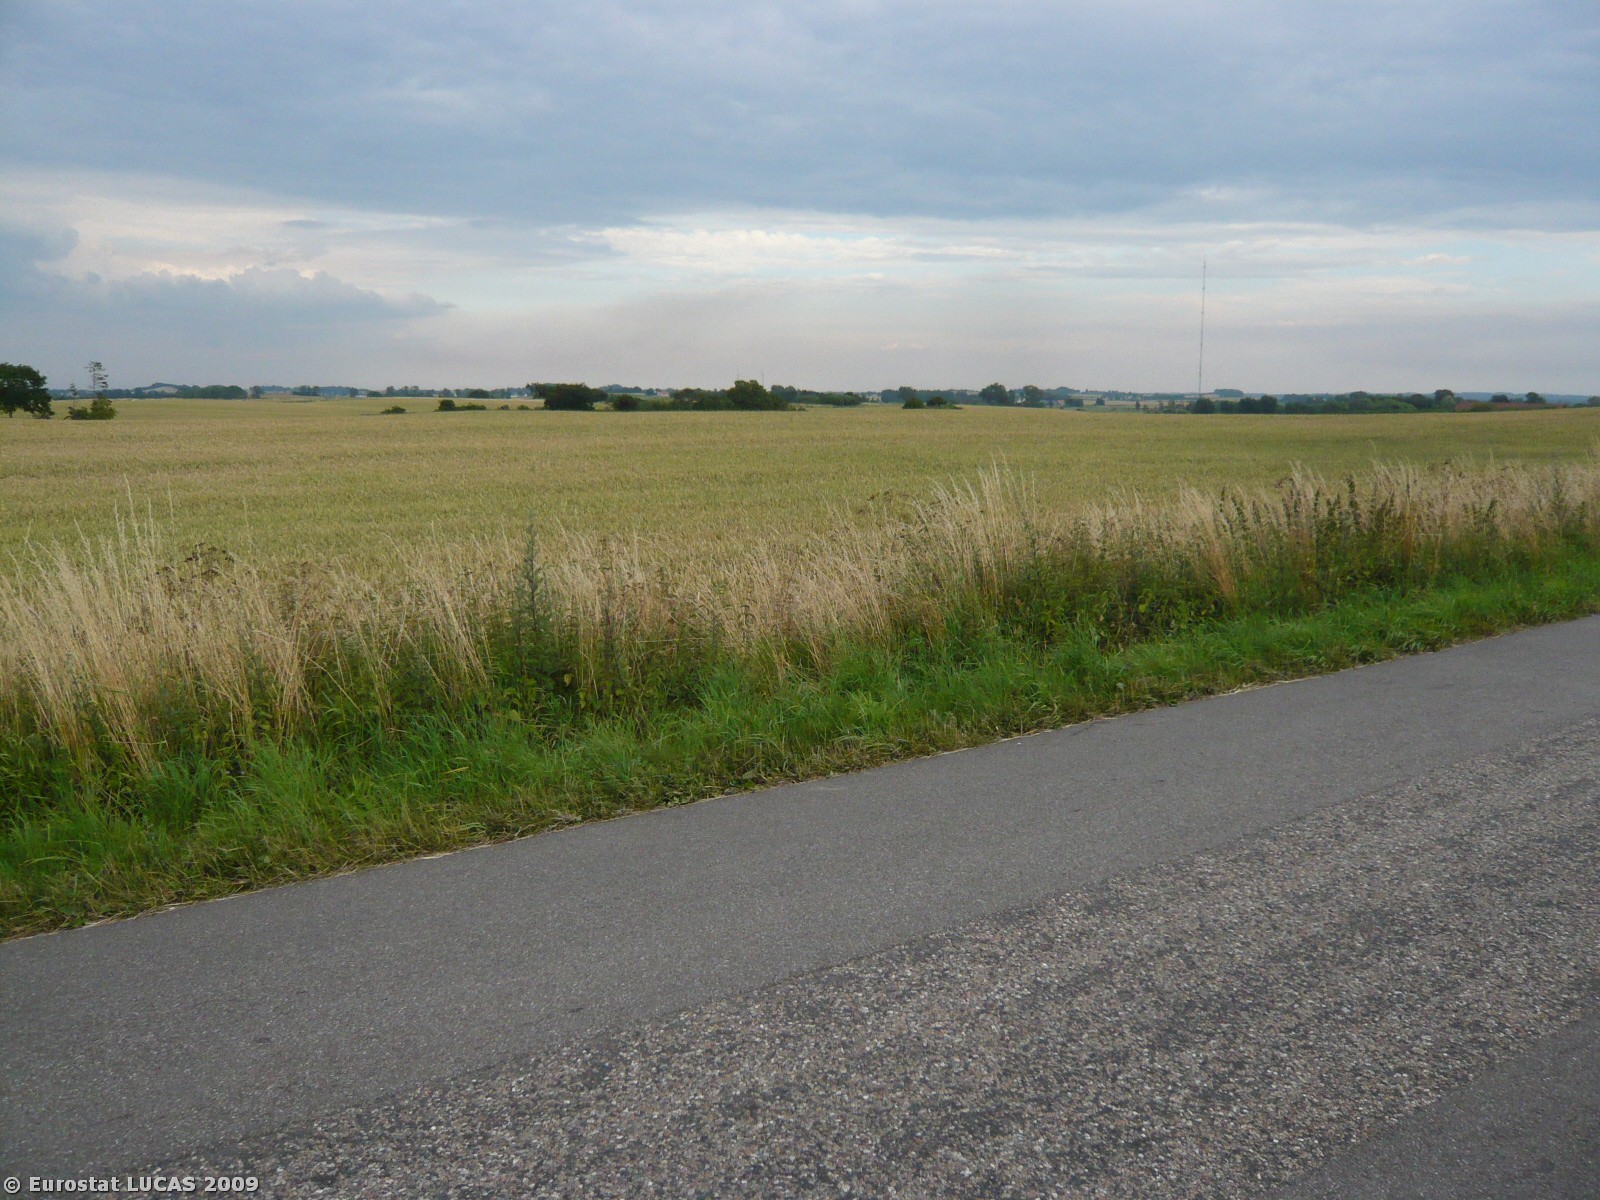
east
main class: Cropland
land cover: Common wheat
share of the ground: > 75 %
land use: Agriculture (excluding fallow land and kitchen gardens)
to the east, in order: Common wheat; Grass margins; Paved roads, cycling and walking lanes; Grass margins; Common wheat
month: July
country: DK
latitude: 55.6945
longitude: 11.4146
